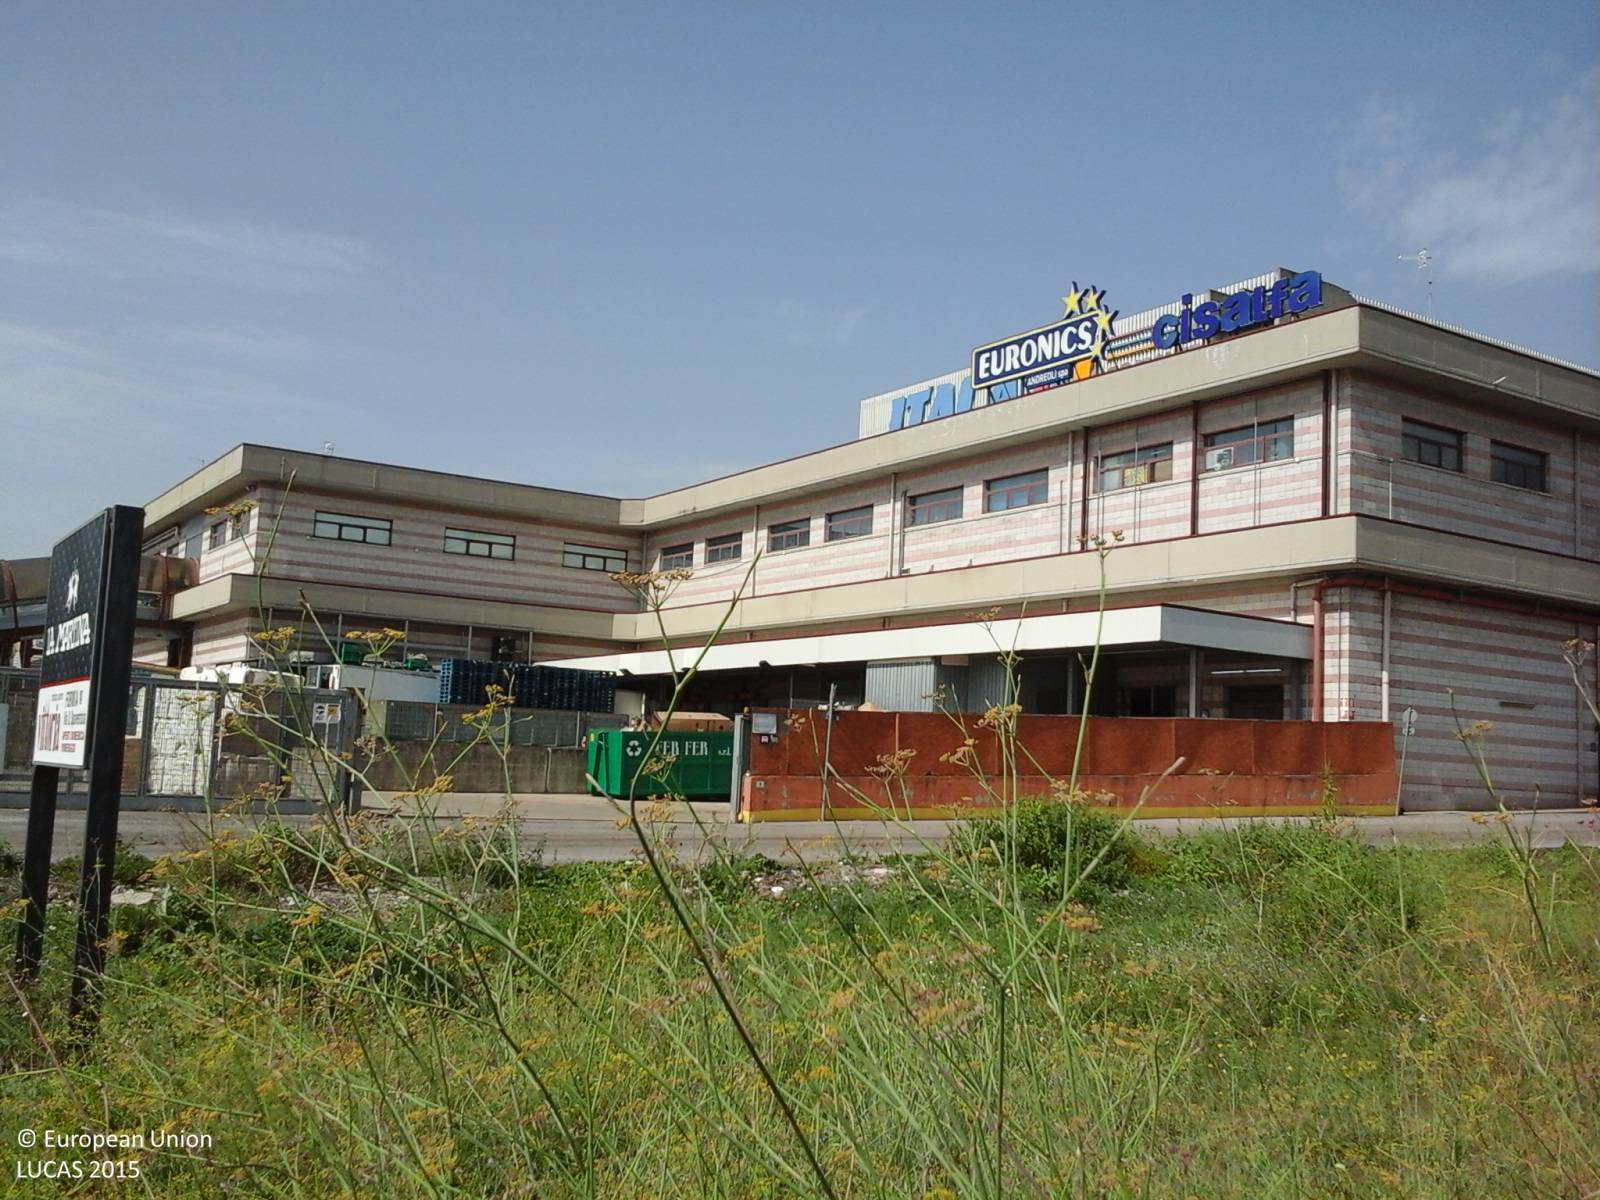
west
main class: Grassland
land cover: Grassland without tree/shrub cover
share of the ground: > 75 %
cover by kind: herbaceous plants 100 %
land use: Abandoned areas
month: September
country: IT
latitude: 41.2670
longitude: 13.6738
